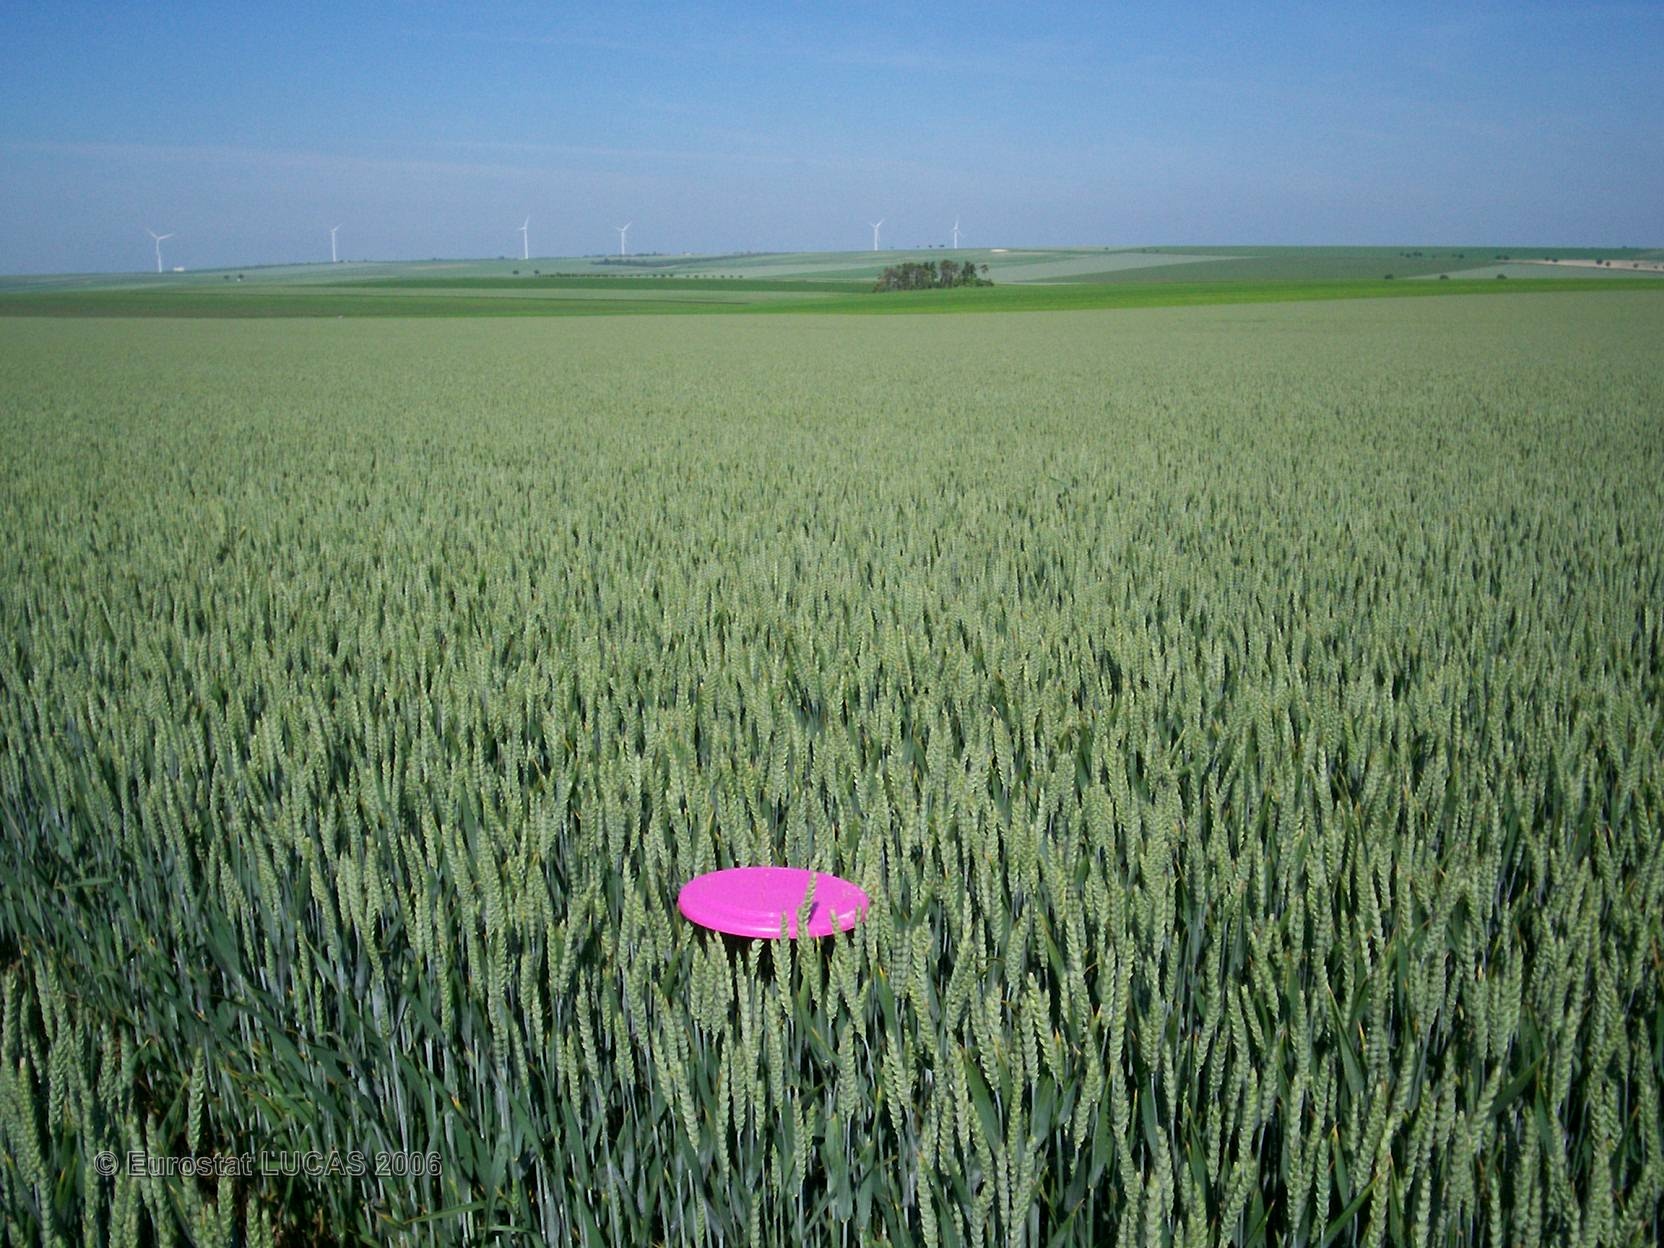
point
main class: Cropland
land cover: Common wheat
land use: Agriculture (excluding fallow land and kitchen gardens)
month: June
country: FR
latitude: 48.8233
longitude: 4.4531
